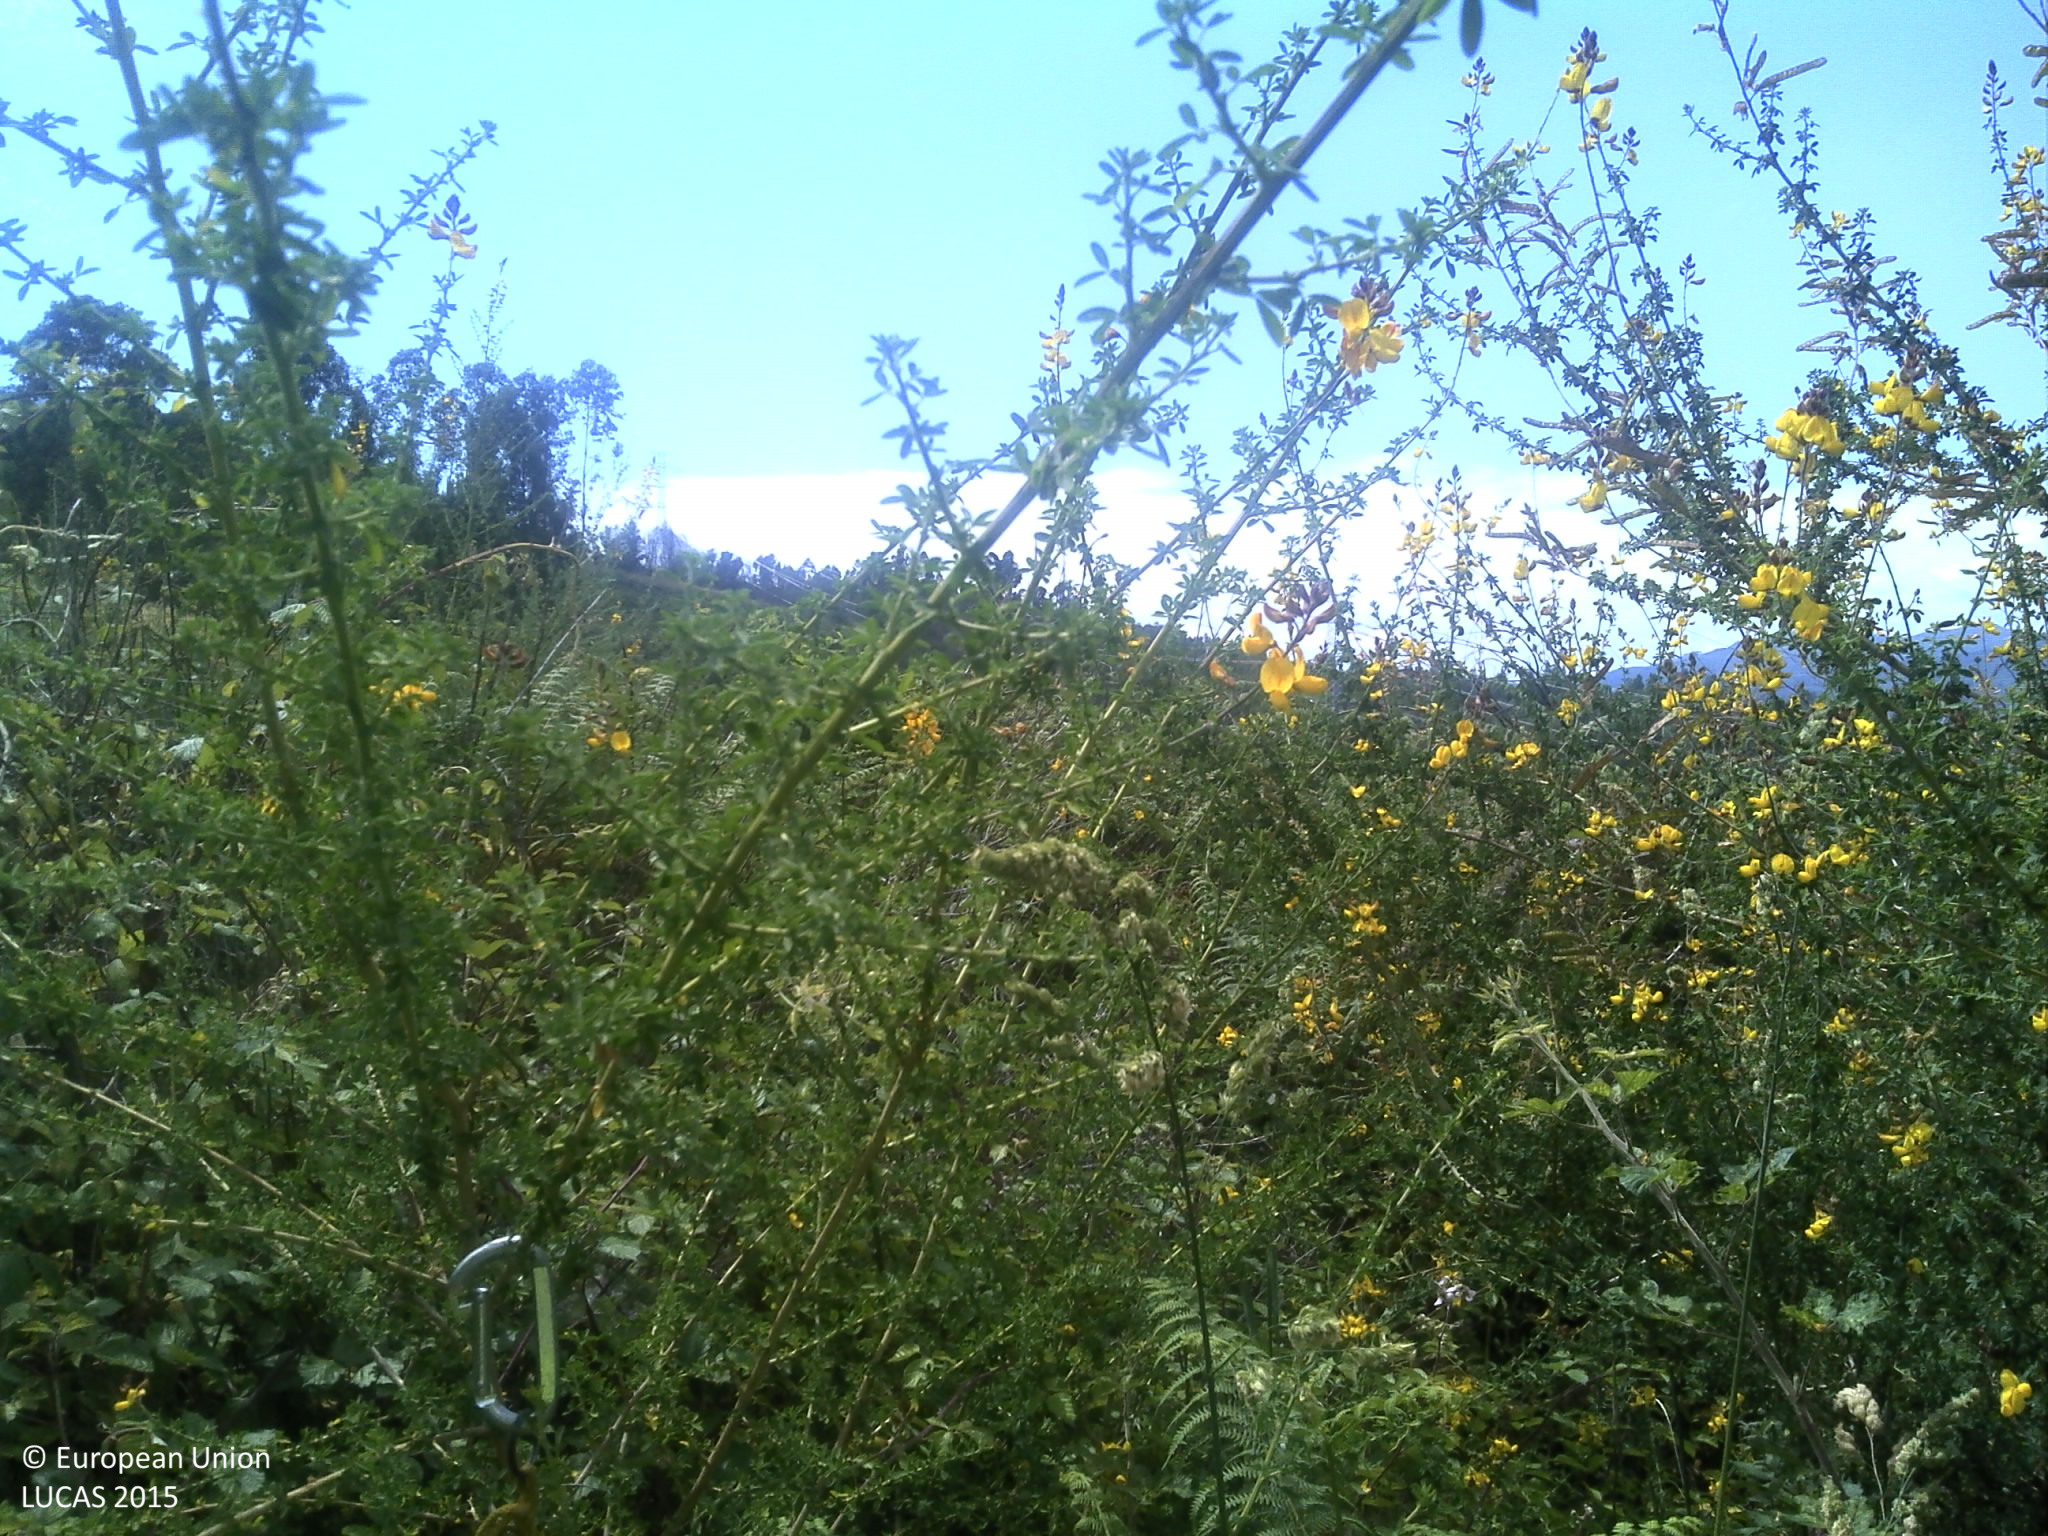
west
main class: Shrubland
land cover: Shrubland with sparse tree cover
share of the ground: > 75 %
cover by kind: shrubs 80 %, herbaceous plants 10 %, broadleaved forest trees 5 %, unconsolidated bare surface 5 %
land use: Semi-natural and natural areas not in use
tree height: > 5 m
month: June
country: PT
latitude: 41.6365
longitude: -8.1915
